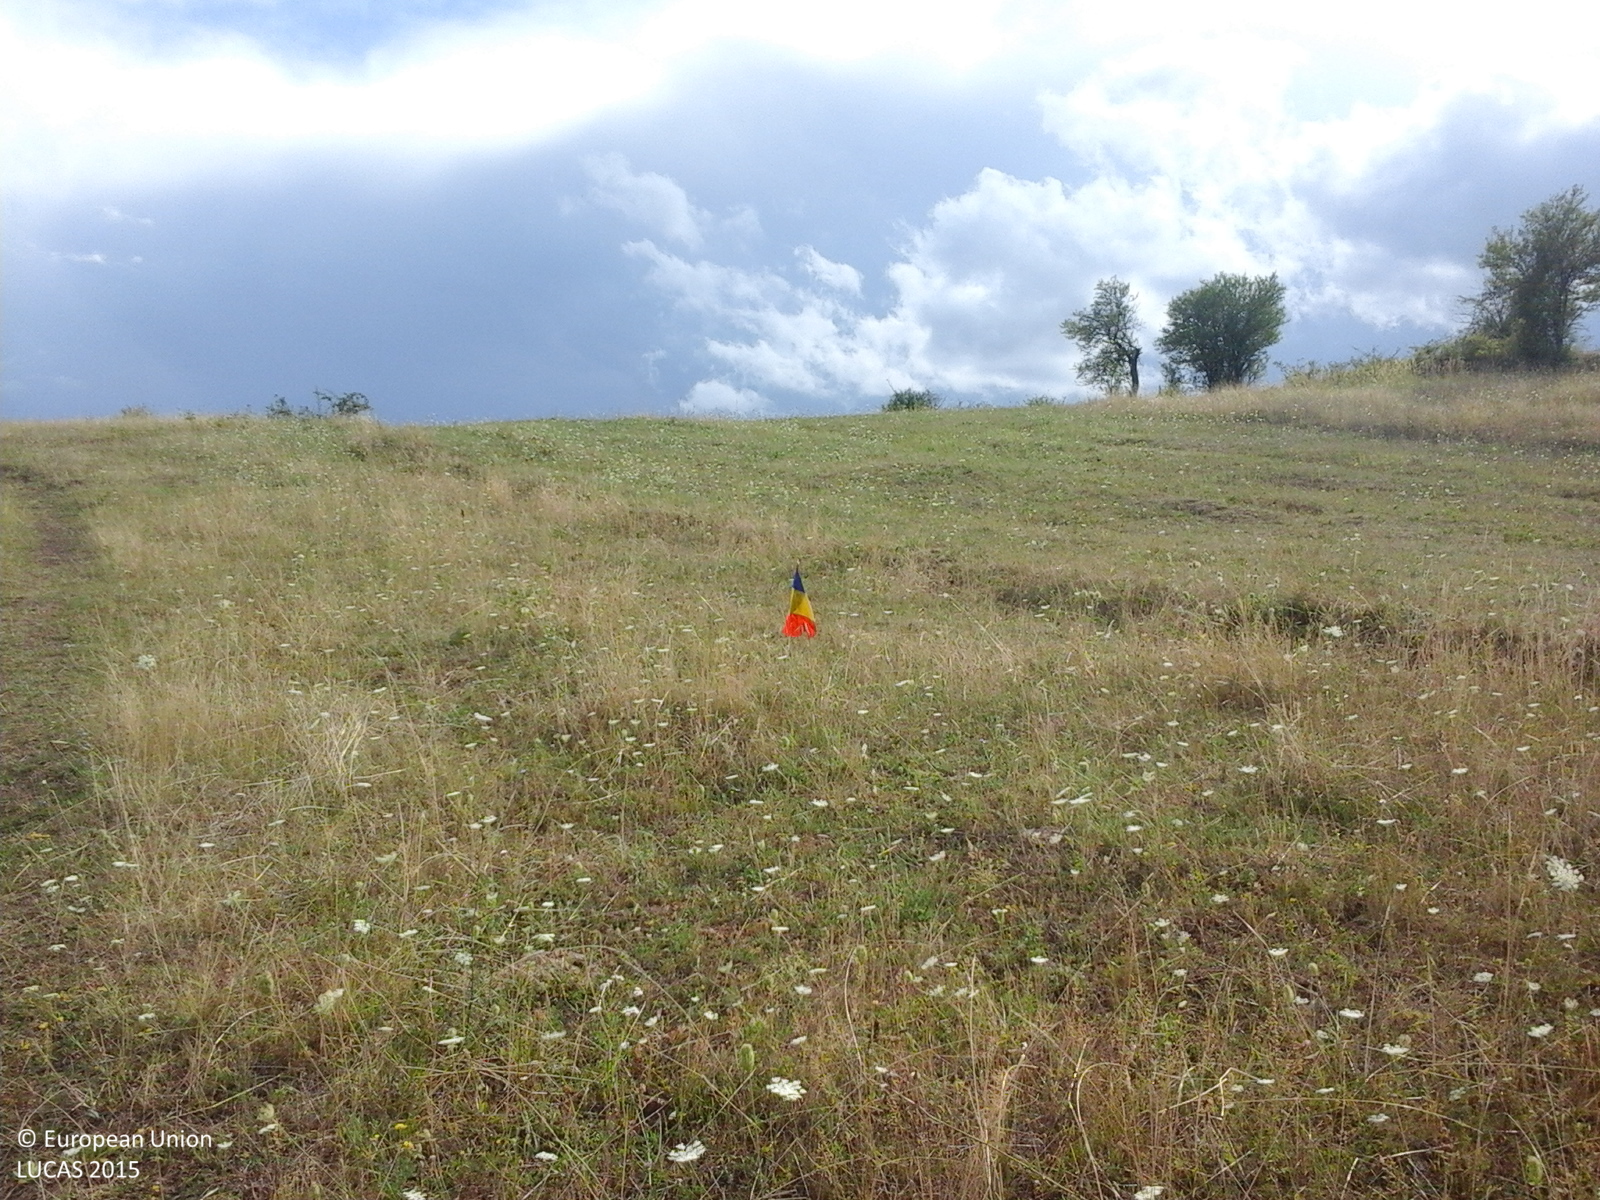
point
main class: Grassland
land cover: Grassland without tree/shrub cover
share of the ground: > 75 %
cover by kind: herbaceous plants 100 %
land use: Agriculture (excluding fallow land and kitchen gardens)
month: August
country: RO
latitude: 44.6404
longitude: 22.8662
